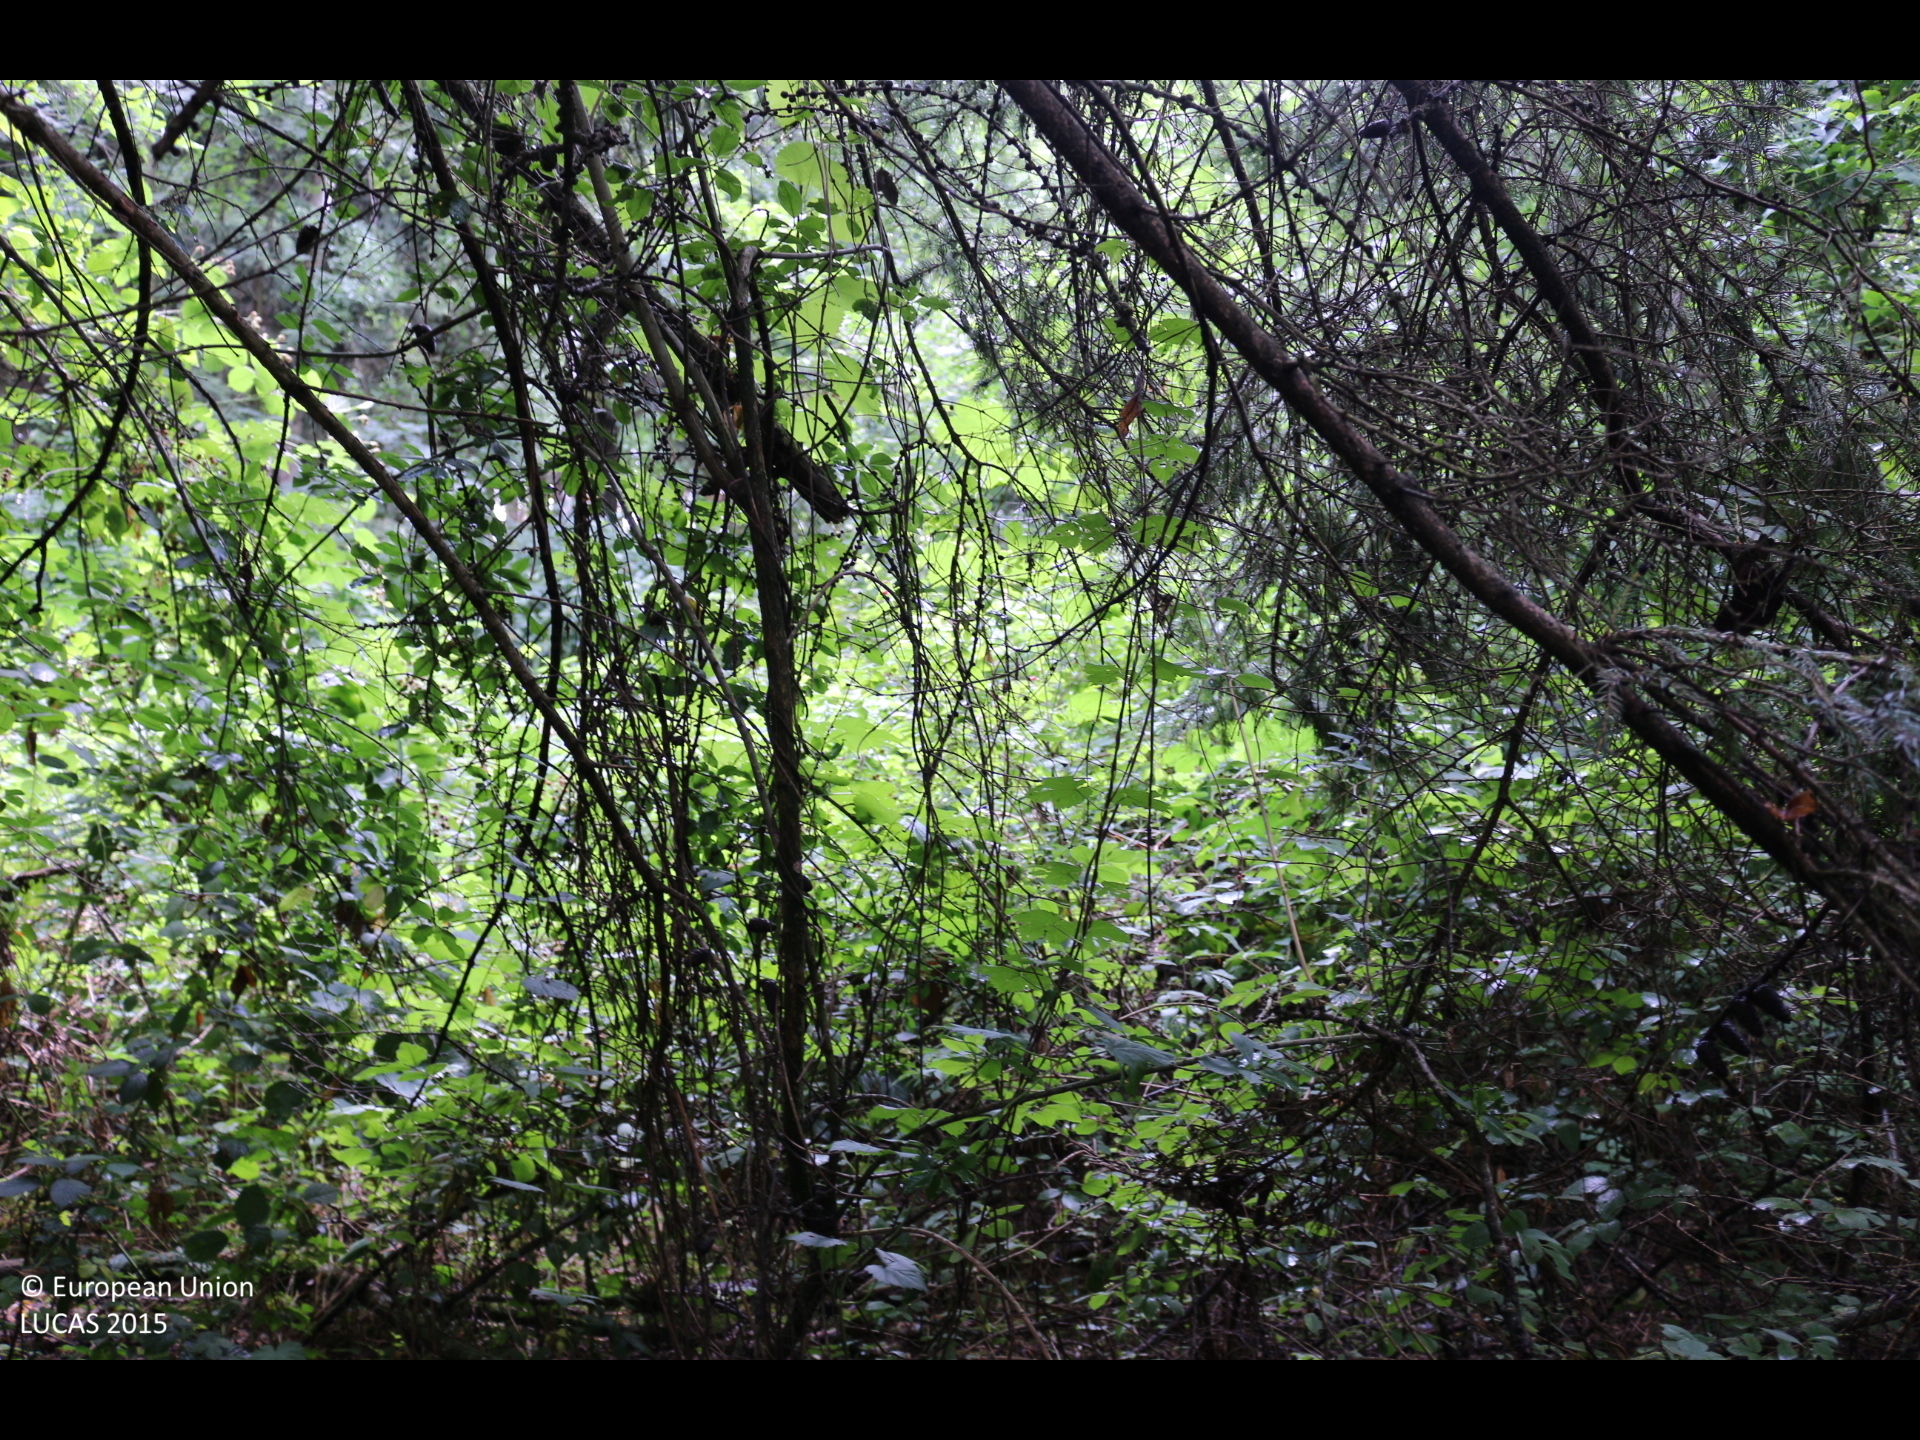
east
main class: Woodland
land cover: Spruce dominated mixed woodland
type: alpine coniferous forest
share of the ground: > 75 %
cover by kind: coniferous forest trees 40 %, broadleaved forest trees 40 %, shrubs 10 %, herbaceous plants 10 %
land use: Forestry
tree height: > 5 m
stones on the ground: < 10 %
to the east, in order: Spruce dominated mixed woodland; Shrubland without tree cover; Spruce dominated mixed woodland; Tracks; Spruce dominated coniferous woodland; Shrubland without tree cover; Spruce dominated coniferous woodland; Shrubland without tree cover; Tracks; Shrubland with sparse tree cover; Spruce dominated mixed woodland; Tracks; Spruce dominated coniferous woodland; Spruce dominated mixed woodland
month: July
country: AT
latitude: 46.8530
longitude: 14.4703
